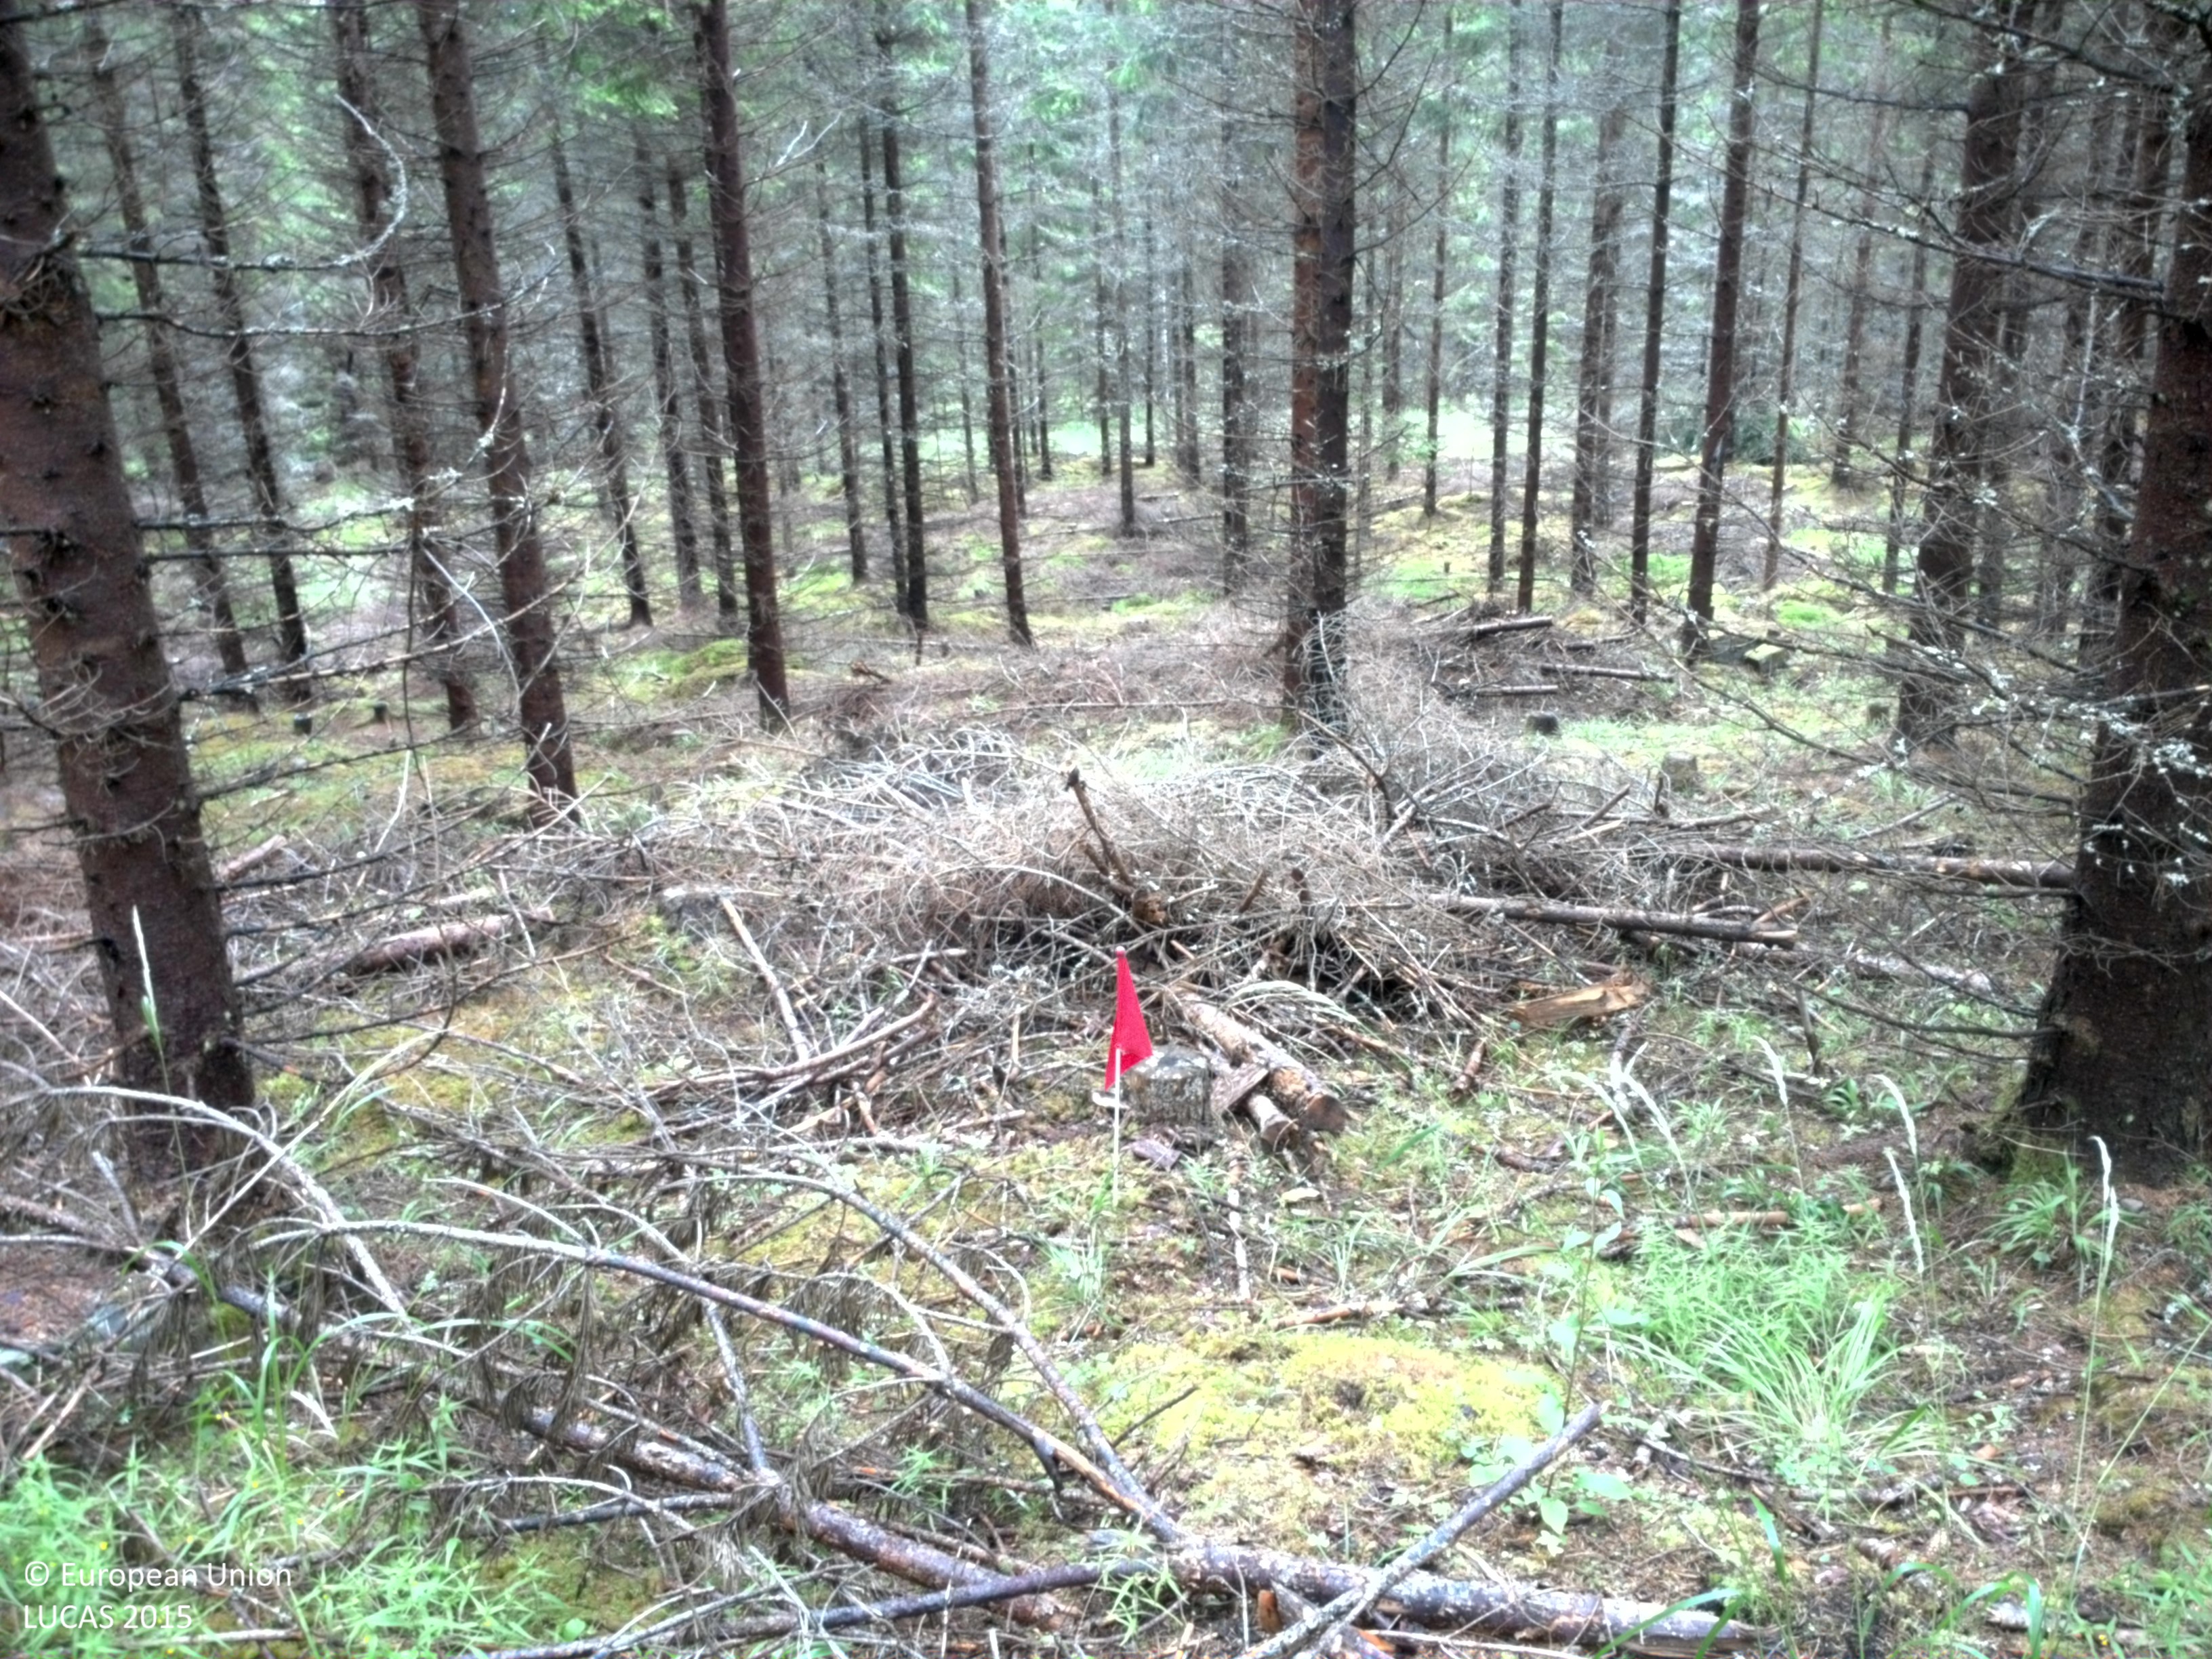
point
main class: Woodland
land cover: Spruce dominated coniferous woodland
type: boreal forest
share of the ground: 50 - 75 %
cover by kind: coniferous forest trees 65 %, lichens and mosses 30 %, herbaceous plants 5 %
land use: Forestry
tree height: > 5 m
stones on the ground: 25 - 50 %
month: July
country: SE
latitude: 59.2420
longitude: 12.3959
